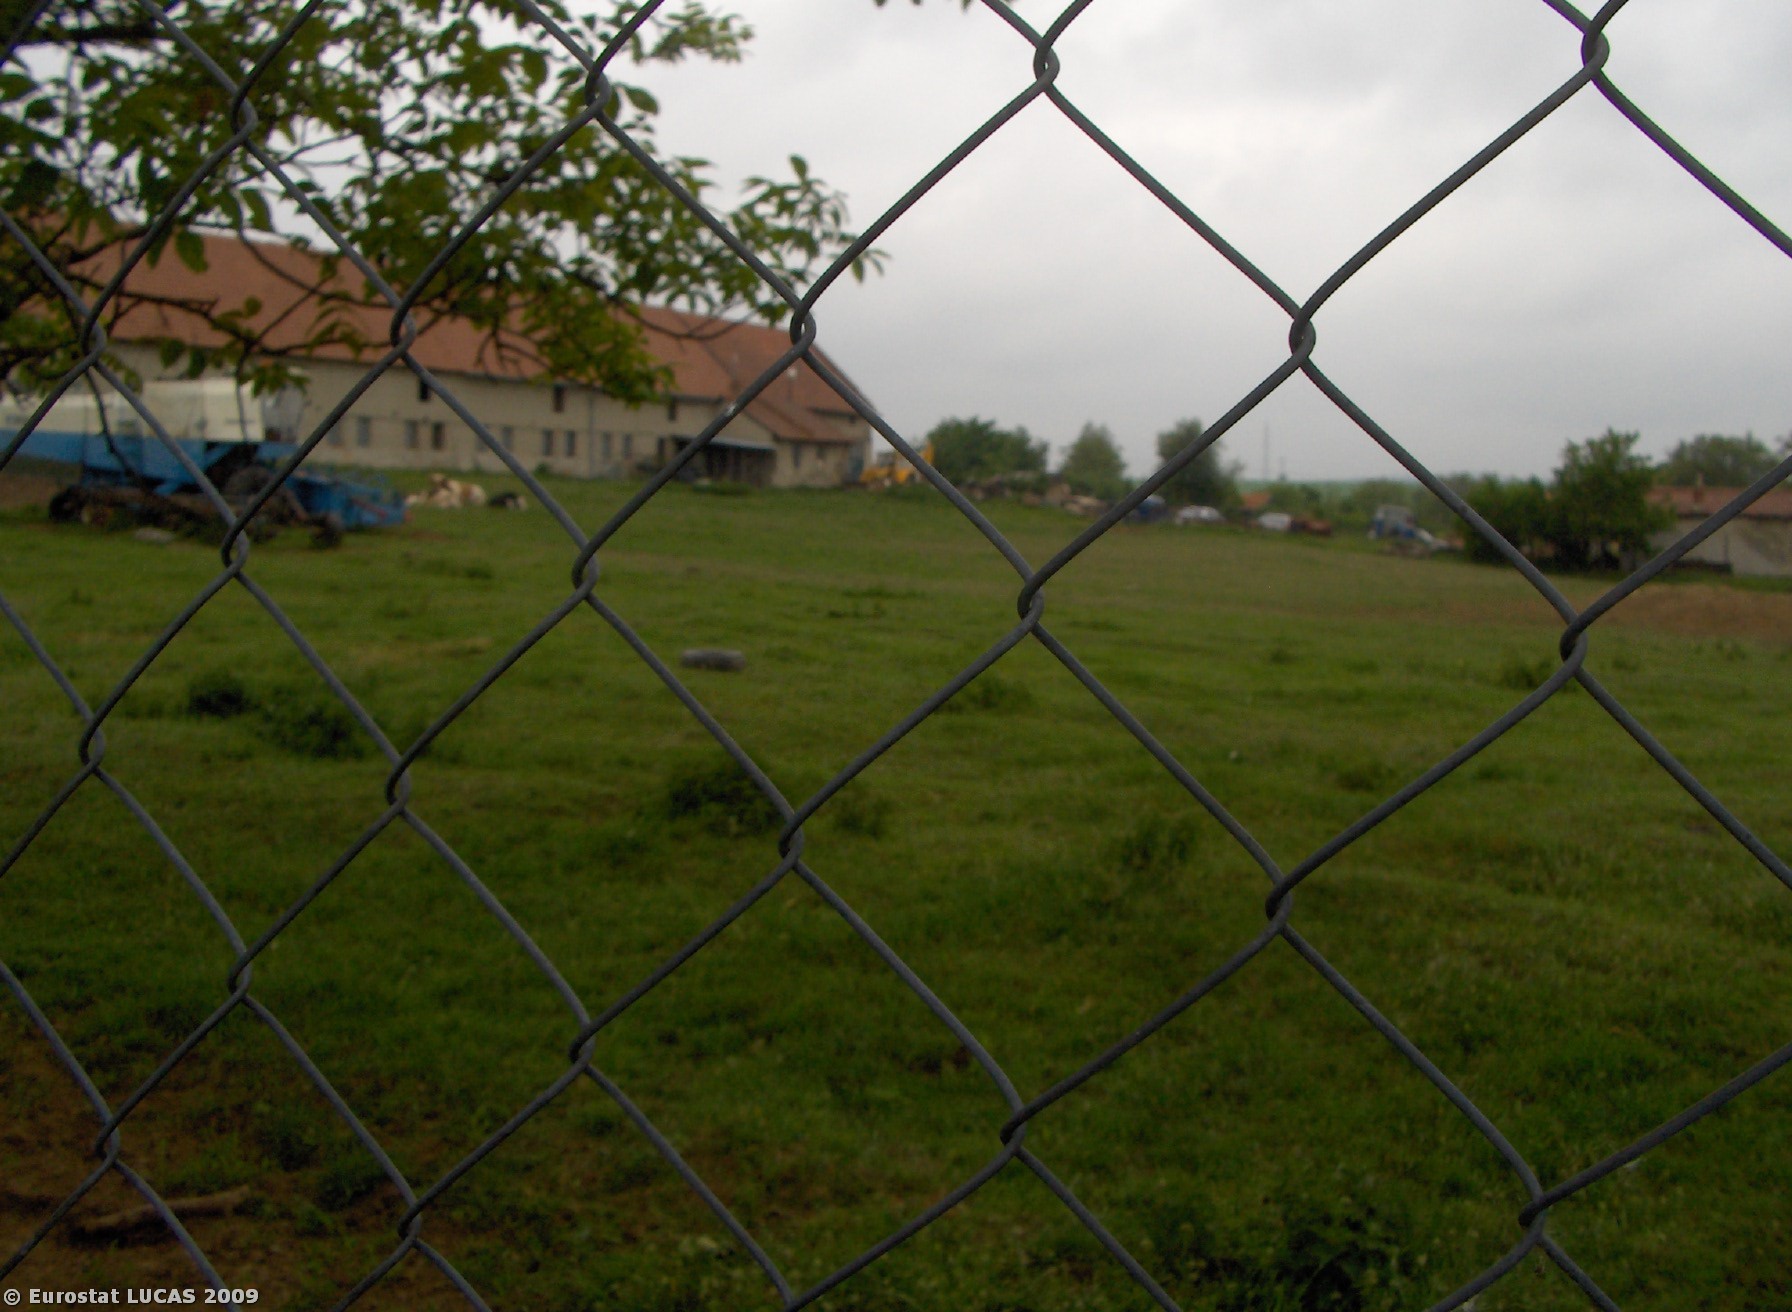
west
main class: Grassland
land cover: Grassland with sparse tree/shrub cover
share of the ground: > 75 %
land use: Agriculture (excluding fallow land and kitchen gardens)
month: May
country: CZ
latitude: 49.3848
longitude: 17.1042
